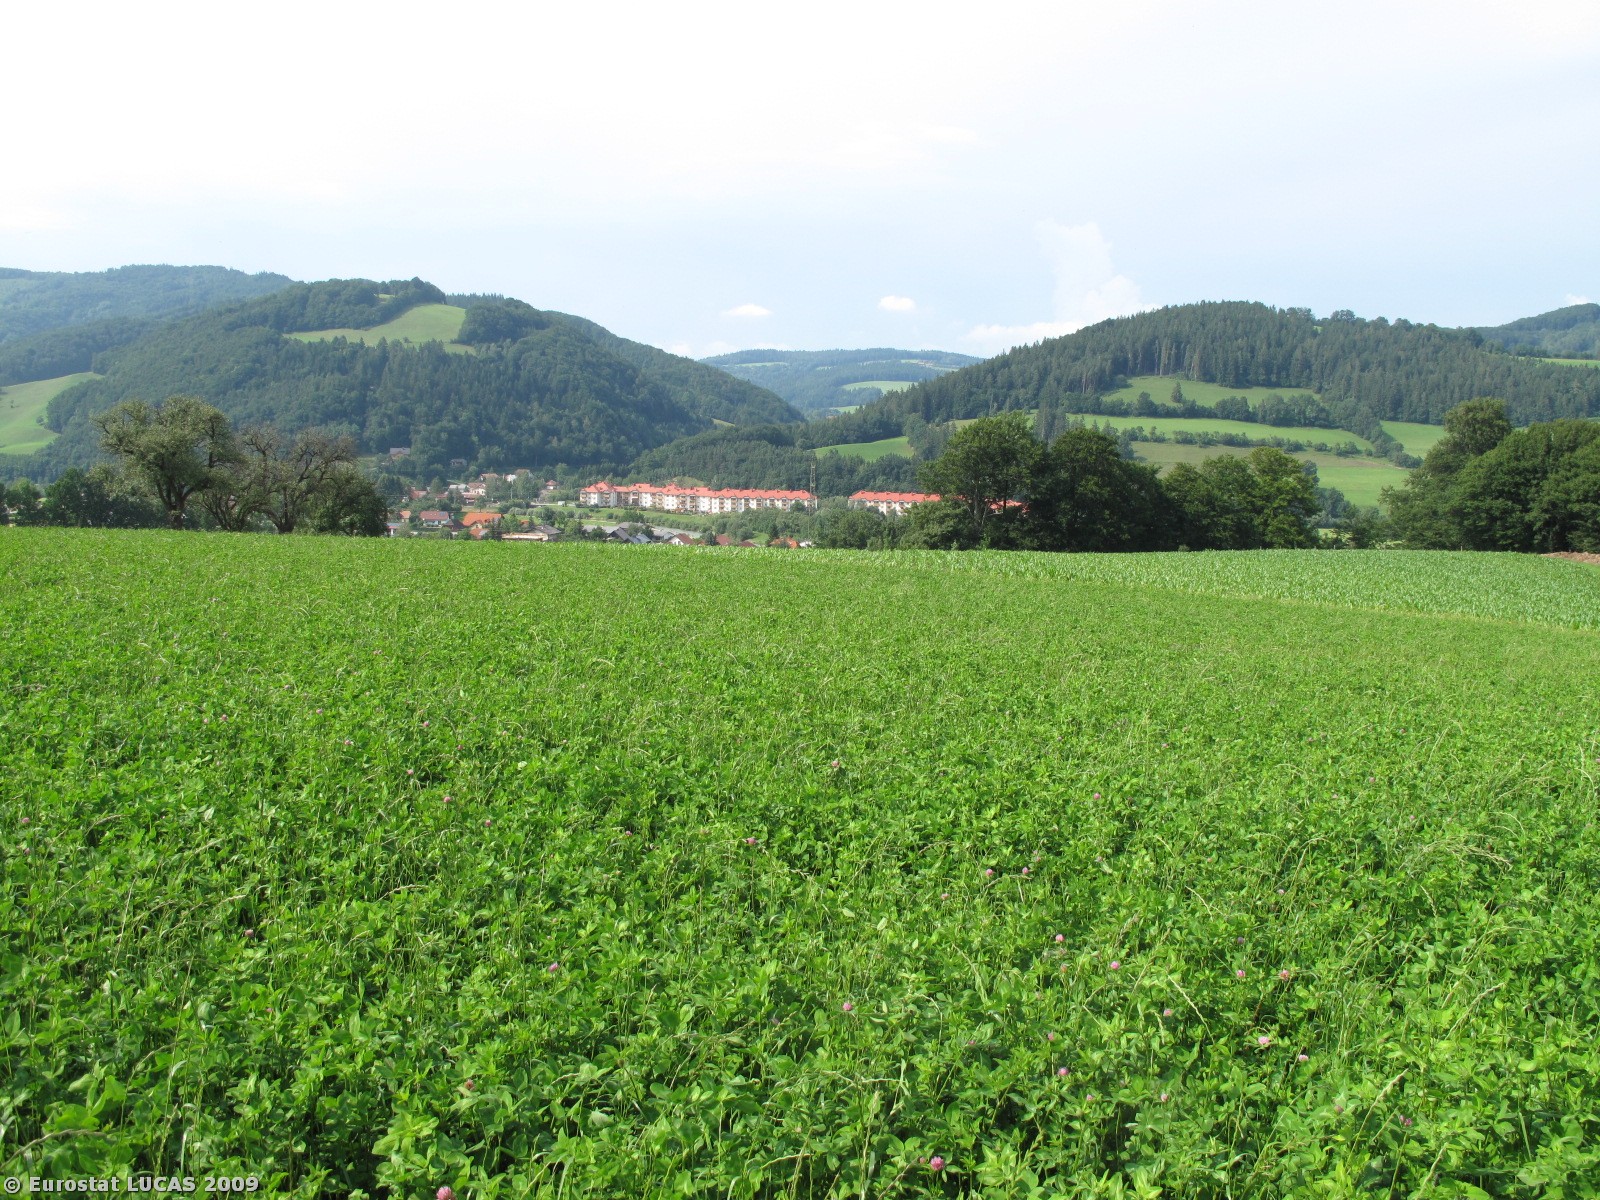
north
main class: Cropland
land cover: Clovers
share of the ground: > 75 %
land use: Agriculture (excluding fallow land and kitchen gardens)
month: July
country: AT
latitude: 48.0426
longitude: 15.6495
